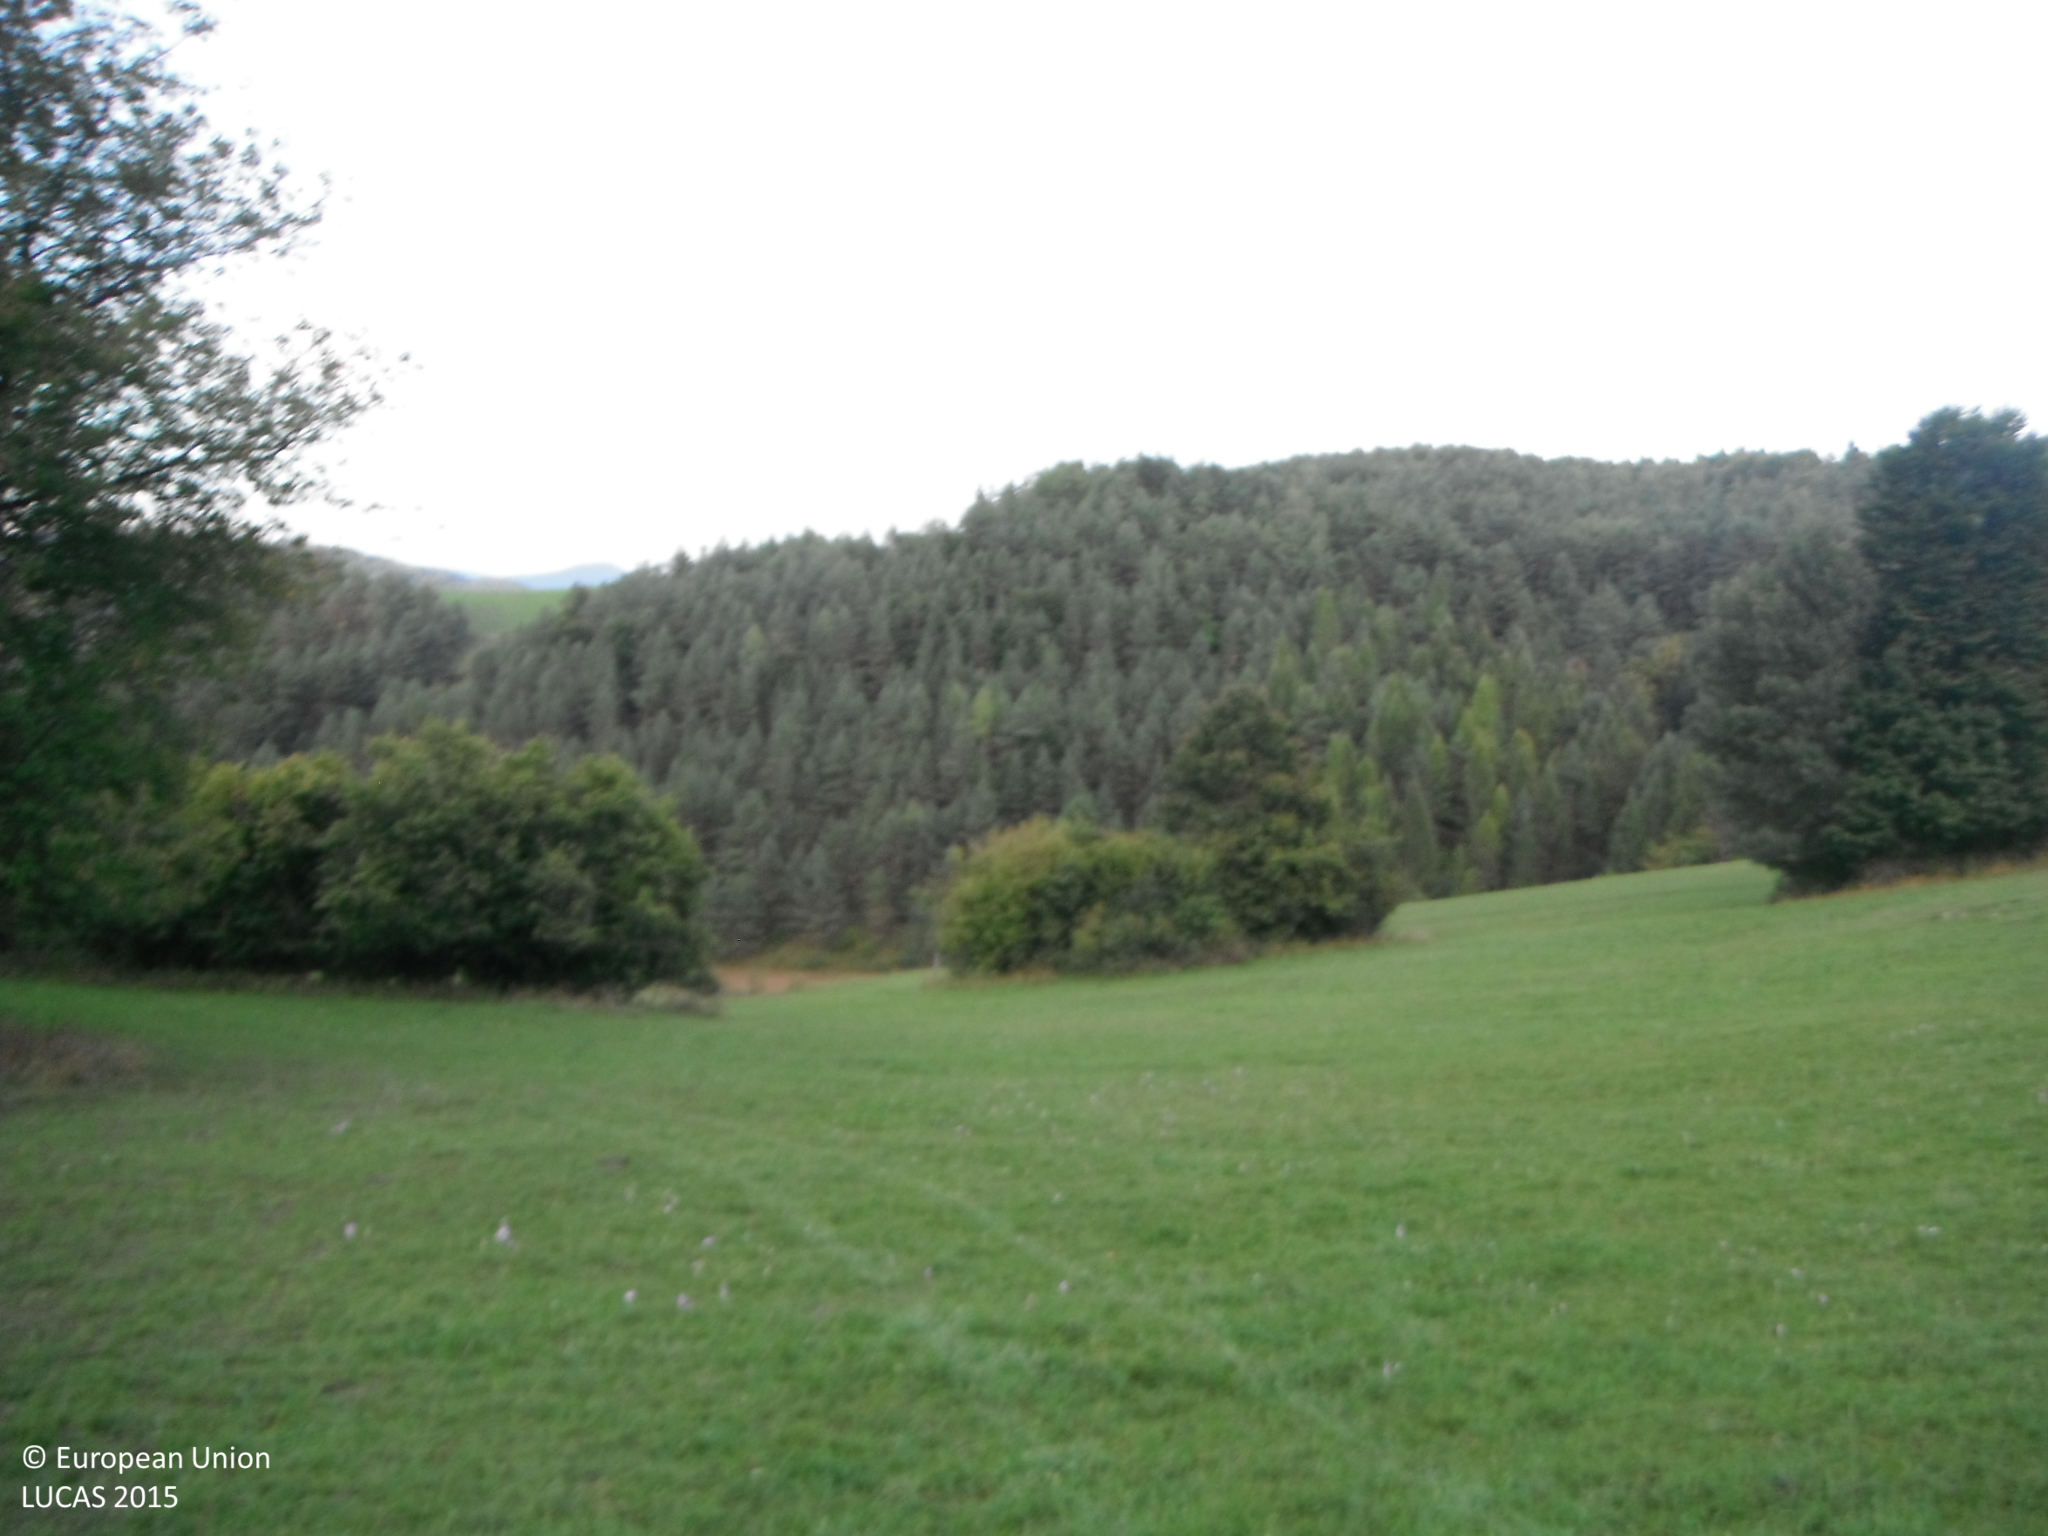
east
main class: Grassland
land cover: Grassland without tree/shrub cover
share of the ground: > 75 %
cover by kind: herbaceous plants 100 %
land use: Agriculture (excluding fallow land and kitchen gardens)
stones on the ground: < 10 %
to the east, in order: Grassland without tree/shrub cover; Broadleaved woodland; Grassland without tree/shrub cover; Tracks; Grassland without tree/shrub cover; Shrubland with sparse tree cover; Tracks; Shrubland with sparse tree cover; Electric lines; Shrubland without tree cover; Rivers and streams; Shrubland without tree cover; Other coniferous woodland
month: September
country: SK
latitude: 48.8811
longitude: 18.3758
